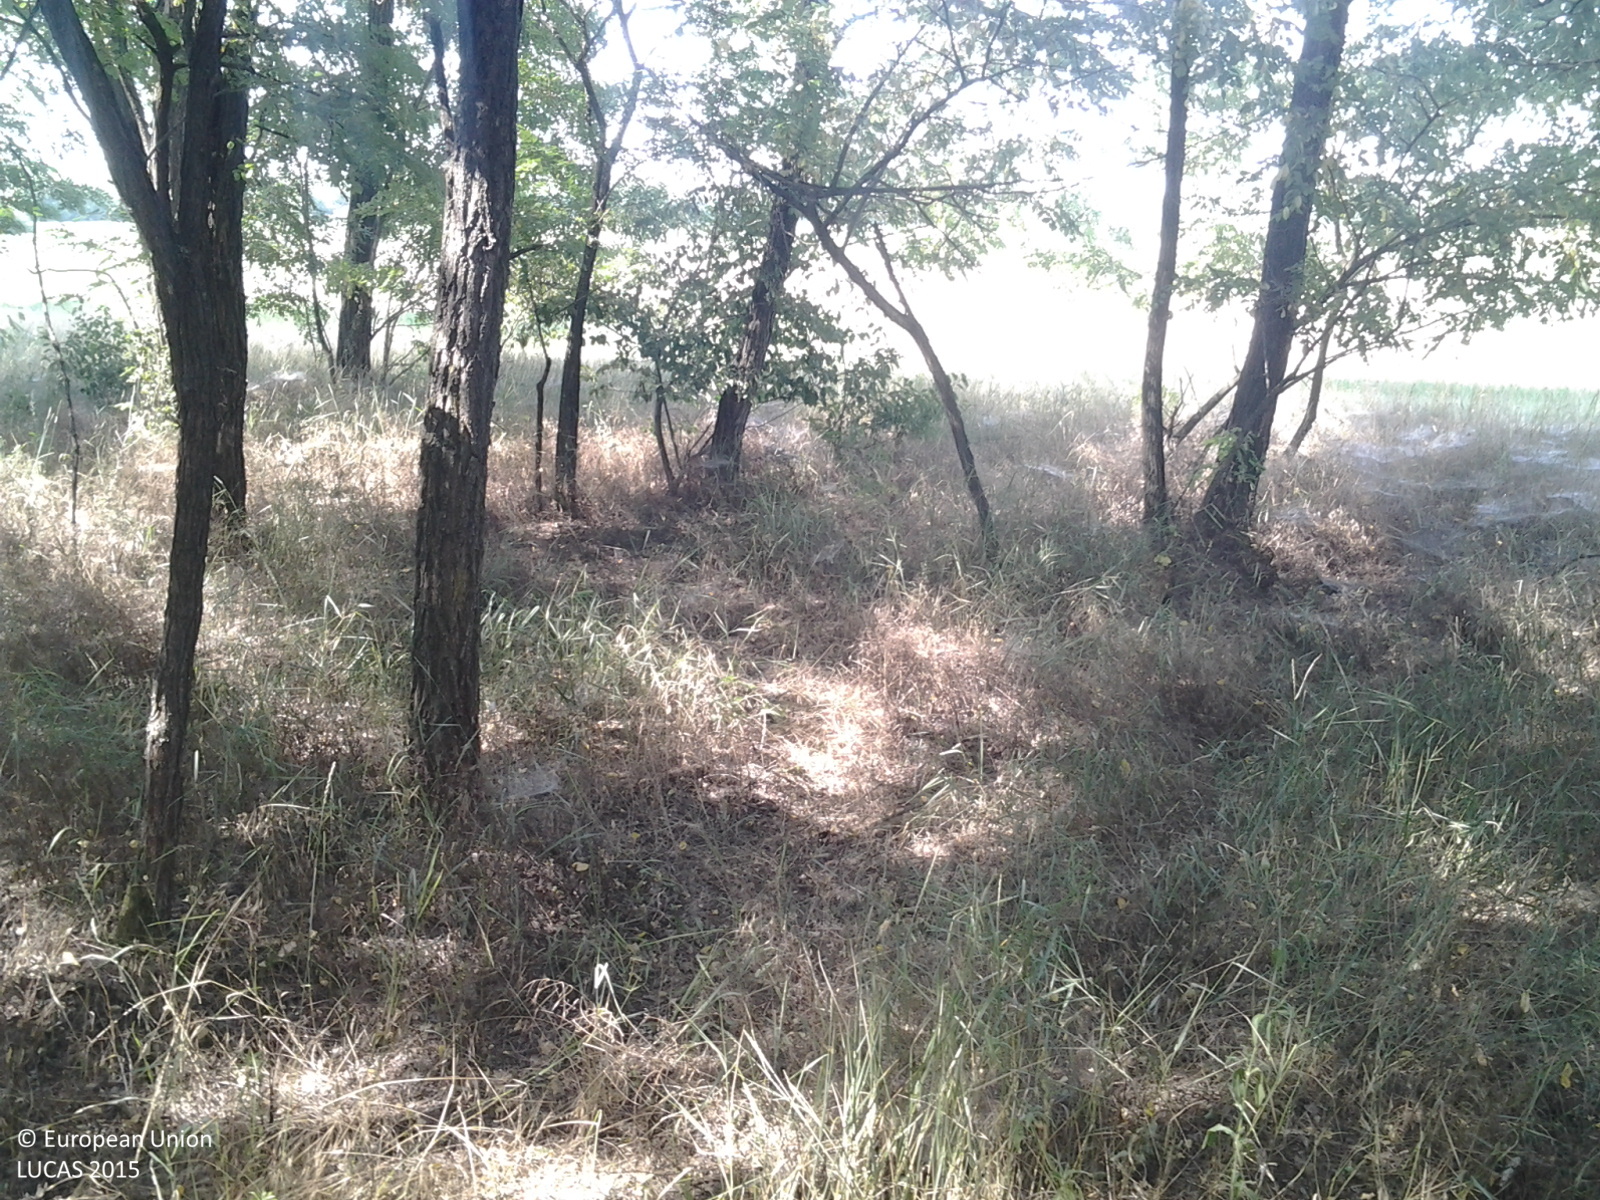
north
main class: Woodland
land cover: Broadleaved woodland
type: mesophytic deciduous forest
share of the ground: 50 - 75 %
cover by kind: broadleaved forest trees 70 %, herbaceous plants 30 %
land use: Forestry
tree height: > 5 m
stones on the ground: < 10 %
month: July
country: HU
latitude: 47.4346
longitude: 19.8758
